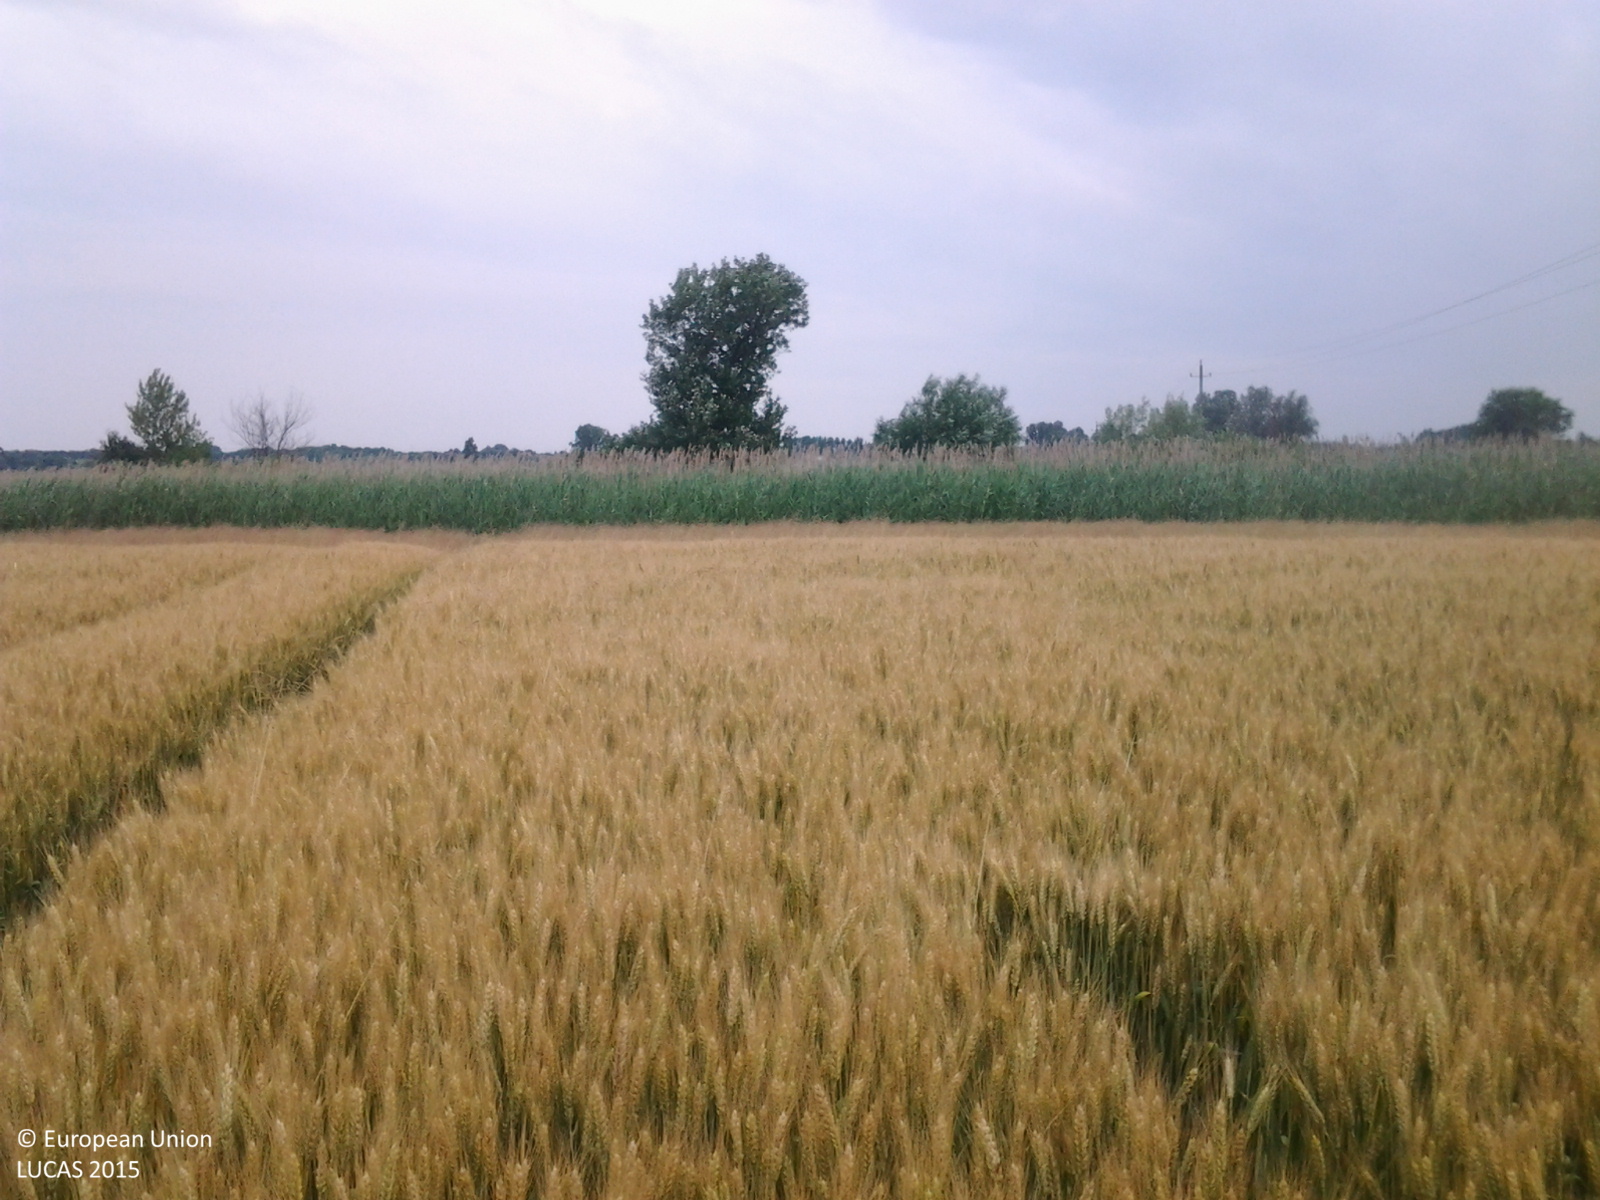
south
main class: Cropland
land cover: Common wheat
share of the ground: > 75 %
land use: Agriculture (excluding fallow land and kitchen gardens)
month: June
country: HU
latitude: 46.3165
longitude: 18.9866
